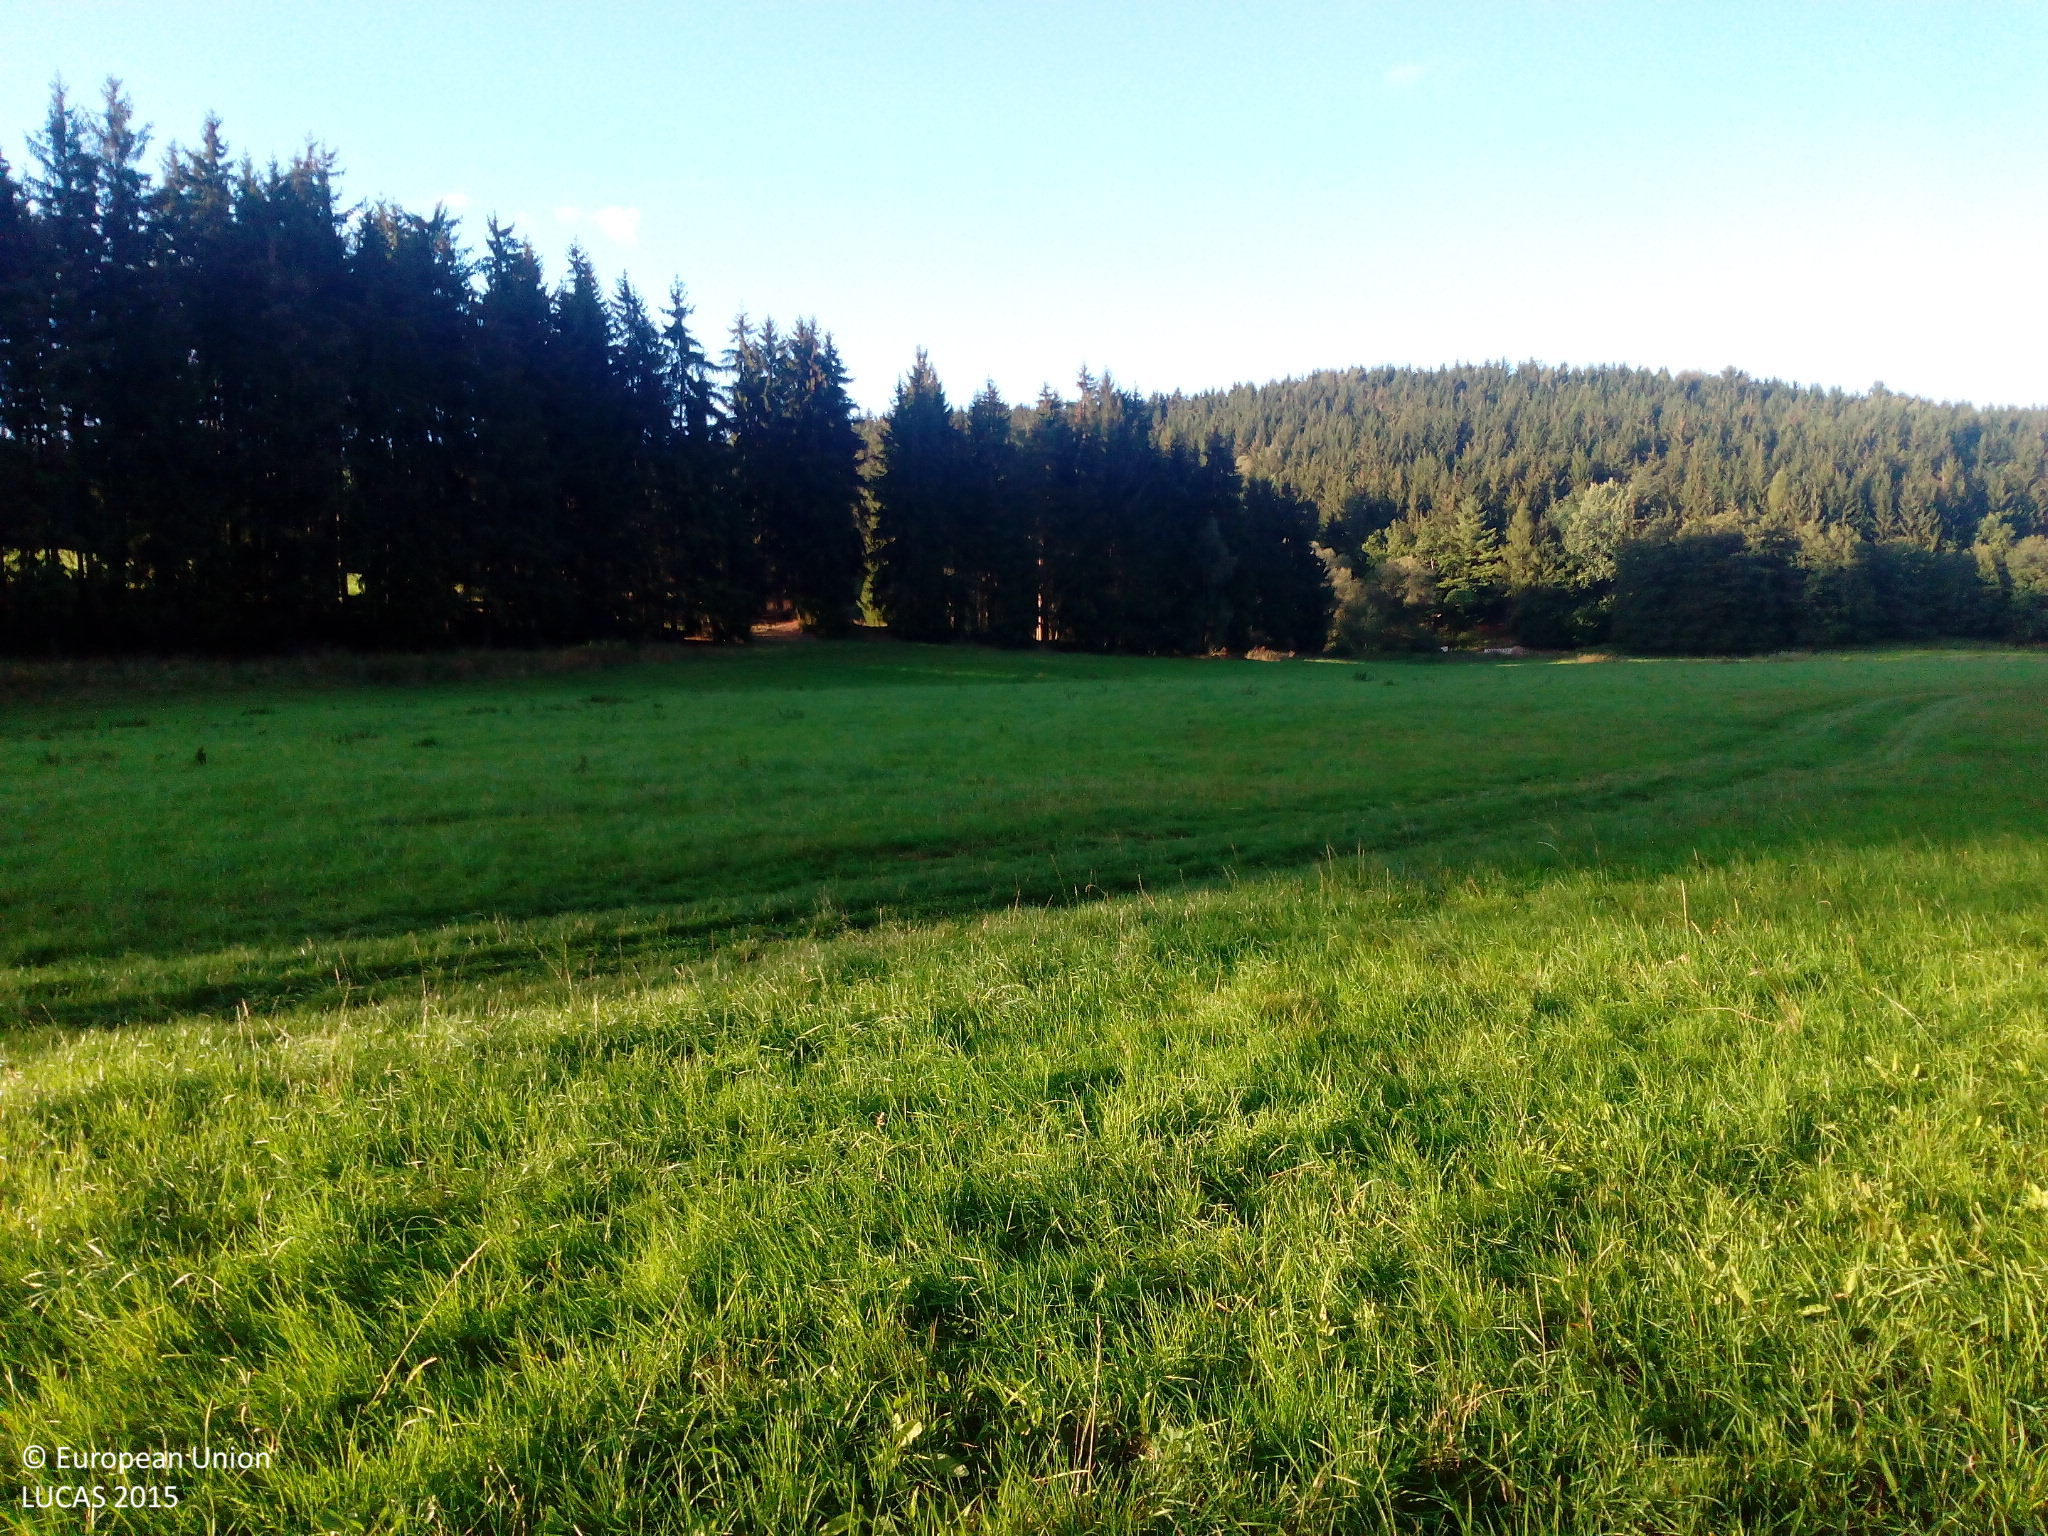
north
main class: Grassland
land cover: Grassland without tree/shrub cover
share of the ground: > 75 %
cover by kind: herbaceous plants 100 %
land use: Agriculture (excluding fallow land and kitchen gardens)
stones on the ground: < 10 %
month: September
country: DE
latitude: 51.5633
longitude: 11.1105
